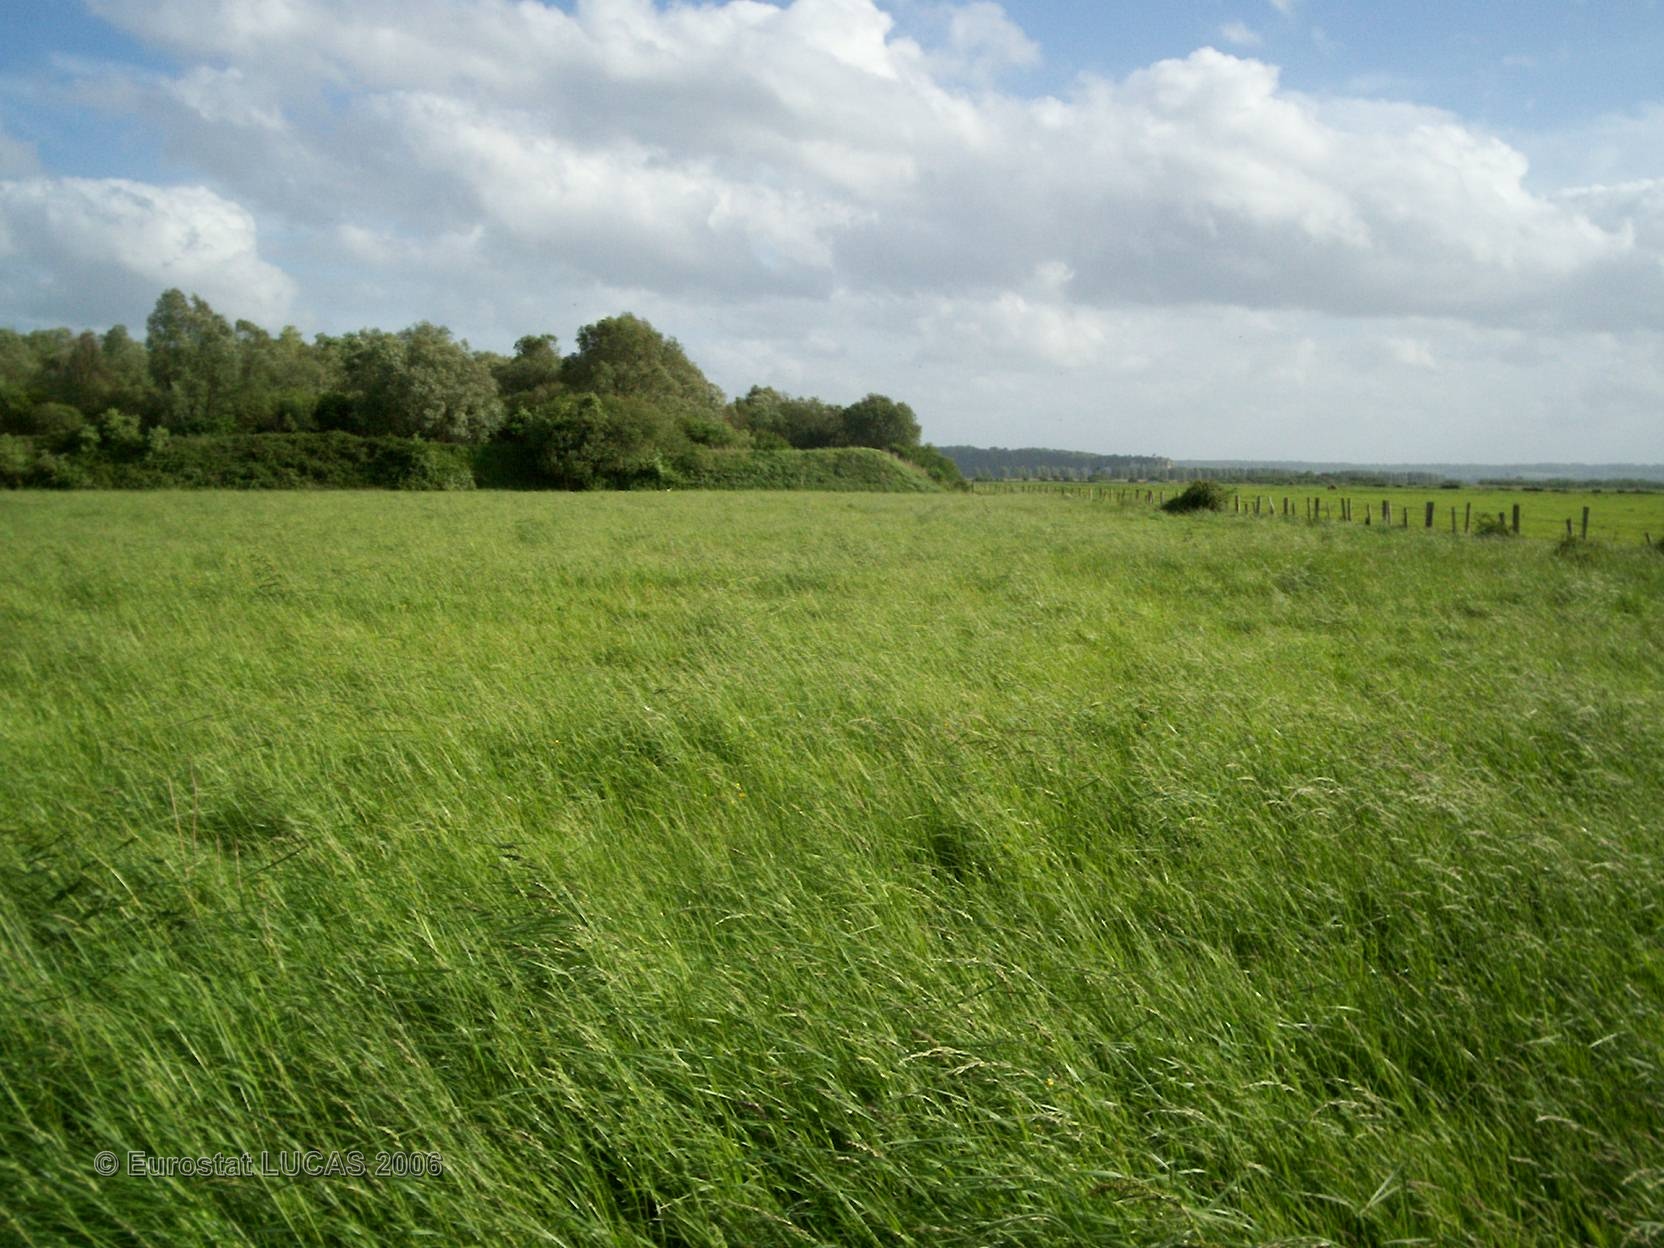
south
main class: Grassland
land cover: Grassland without tree/shrub cover
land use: Agriculture (excluding fallow land and kitchen gardens)
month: May
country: FR
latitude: 49.4735
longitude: 0.4366
